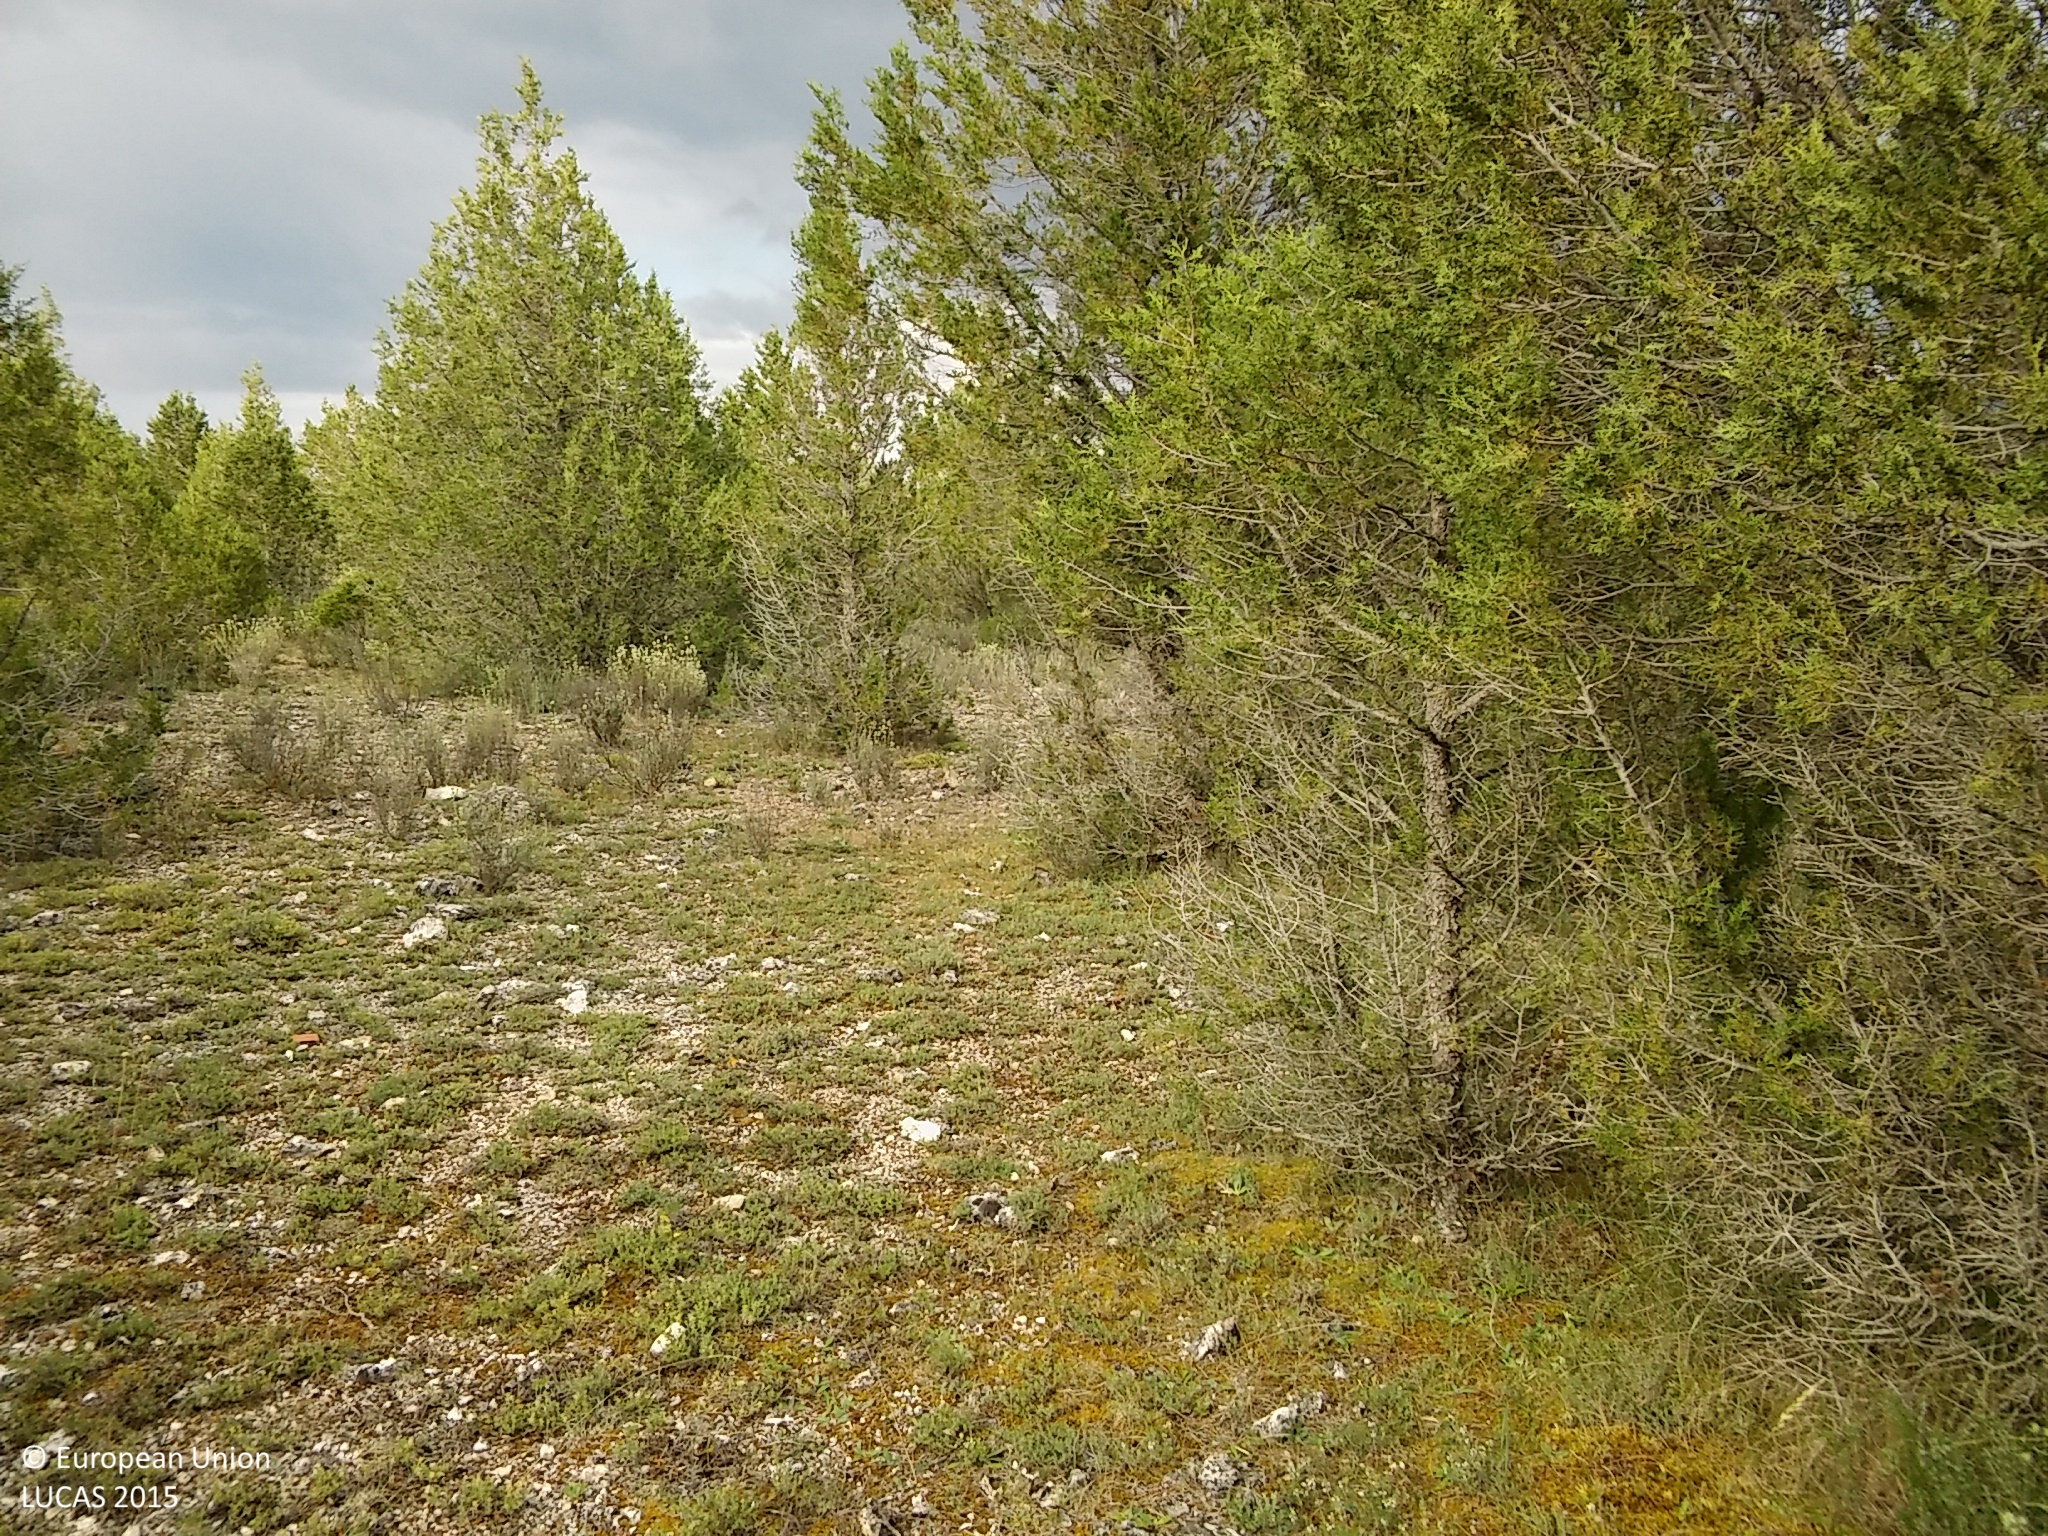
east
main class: Woodland
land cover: Other coniferous woodland
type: coniferous forest of the mediterranean region
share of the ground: 25 - 50 %
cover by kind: coniferous forest trees 30 %, shrubs 20 %, lichens and mosses 20 %, unconsolidated bare surface 20 %, herbaceous plants 10 %
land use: Forestry
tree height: > 5 m
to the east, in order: Other coniferous woodland
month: June
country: ES
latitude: 41.1765
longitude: -3.6474
